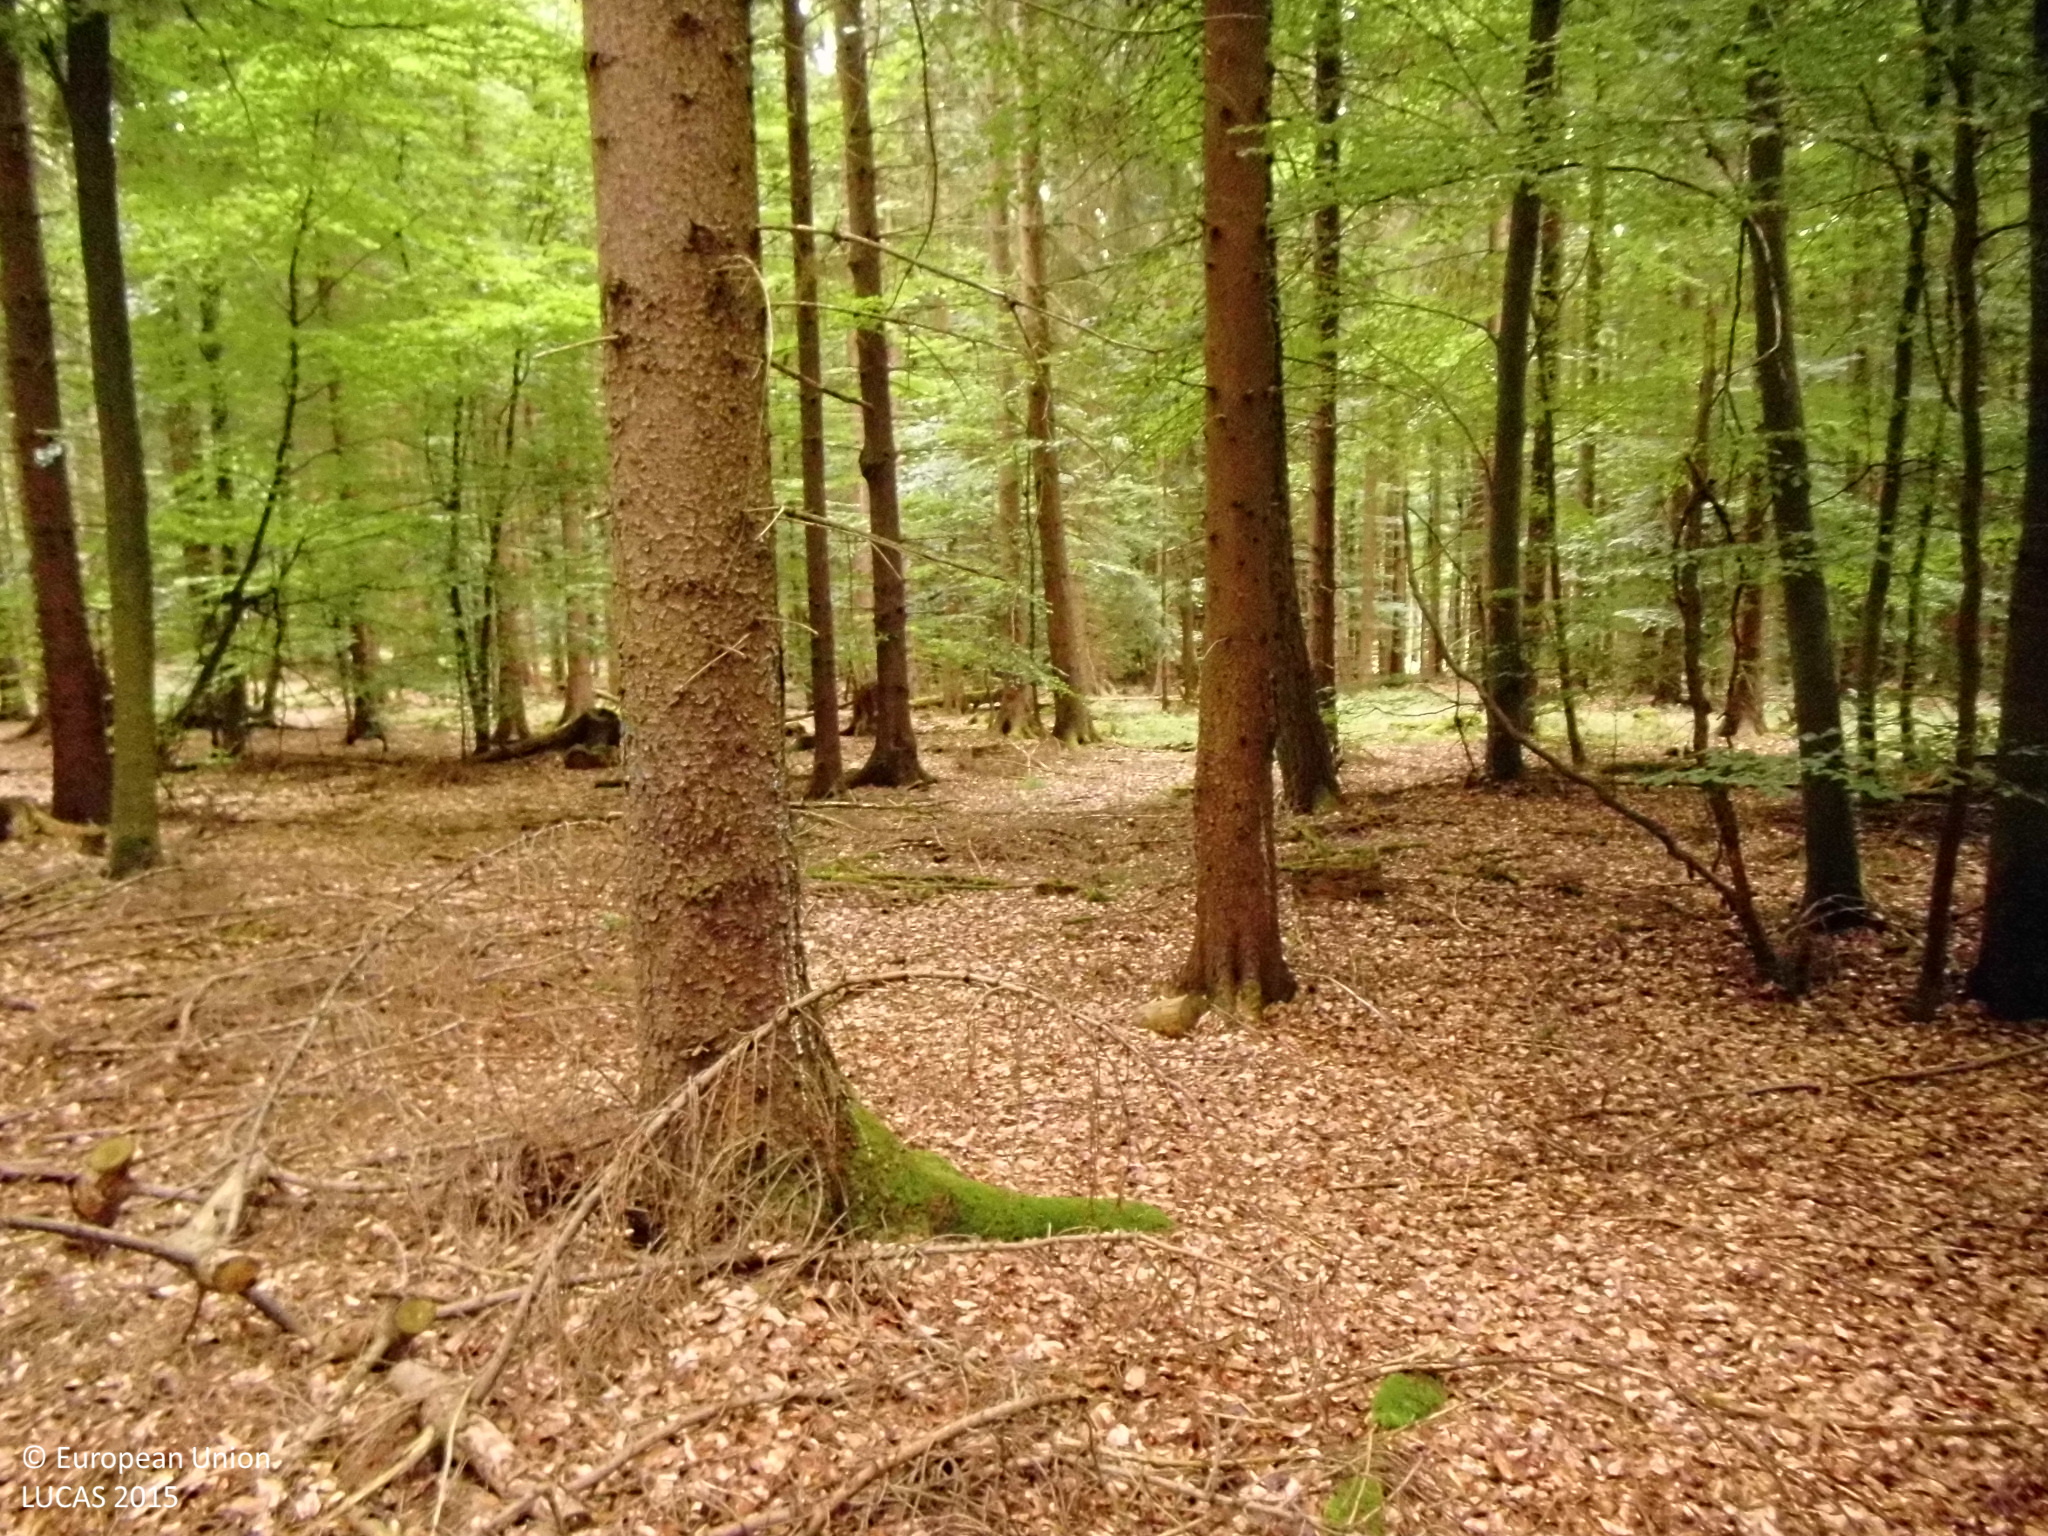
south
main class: Woodland
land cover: Spruce dominated mixed woodland
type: hemiboreal forest and nemoral coniferous forest and mixed broadleaved-coniferous forest
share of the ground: > 75 %
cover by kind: coniferous forest trees 60 %, broadleaved forest trees 35 %, unconsolidated bare surface 5 %
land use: Forestry
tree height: > 5 m
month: July
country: DE
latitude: 50.4077
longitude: 8.4667
